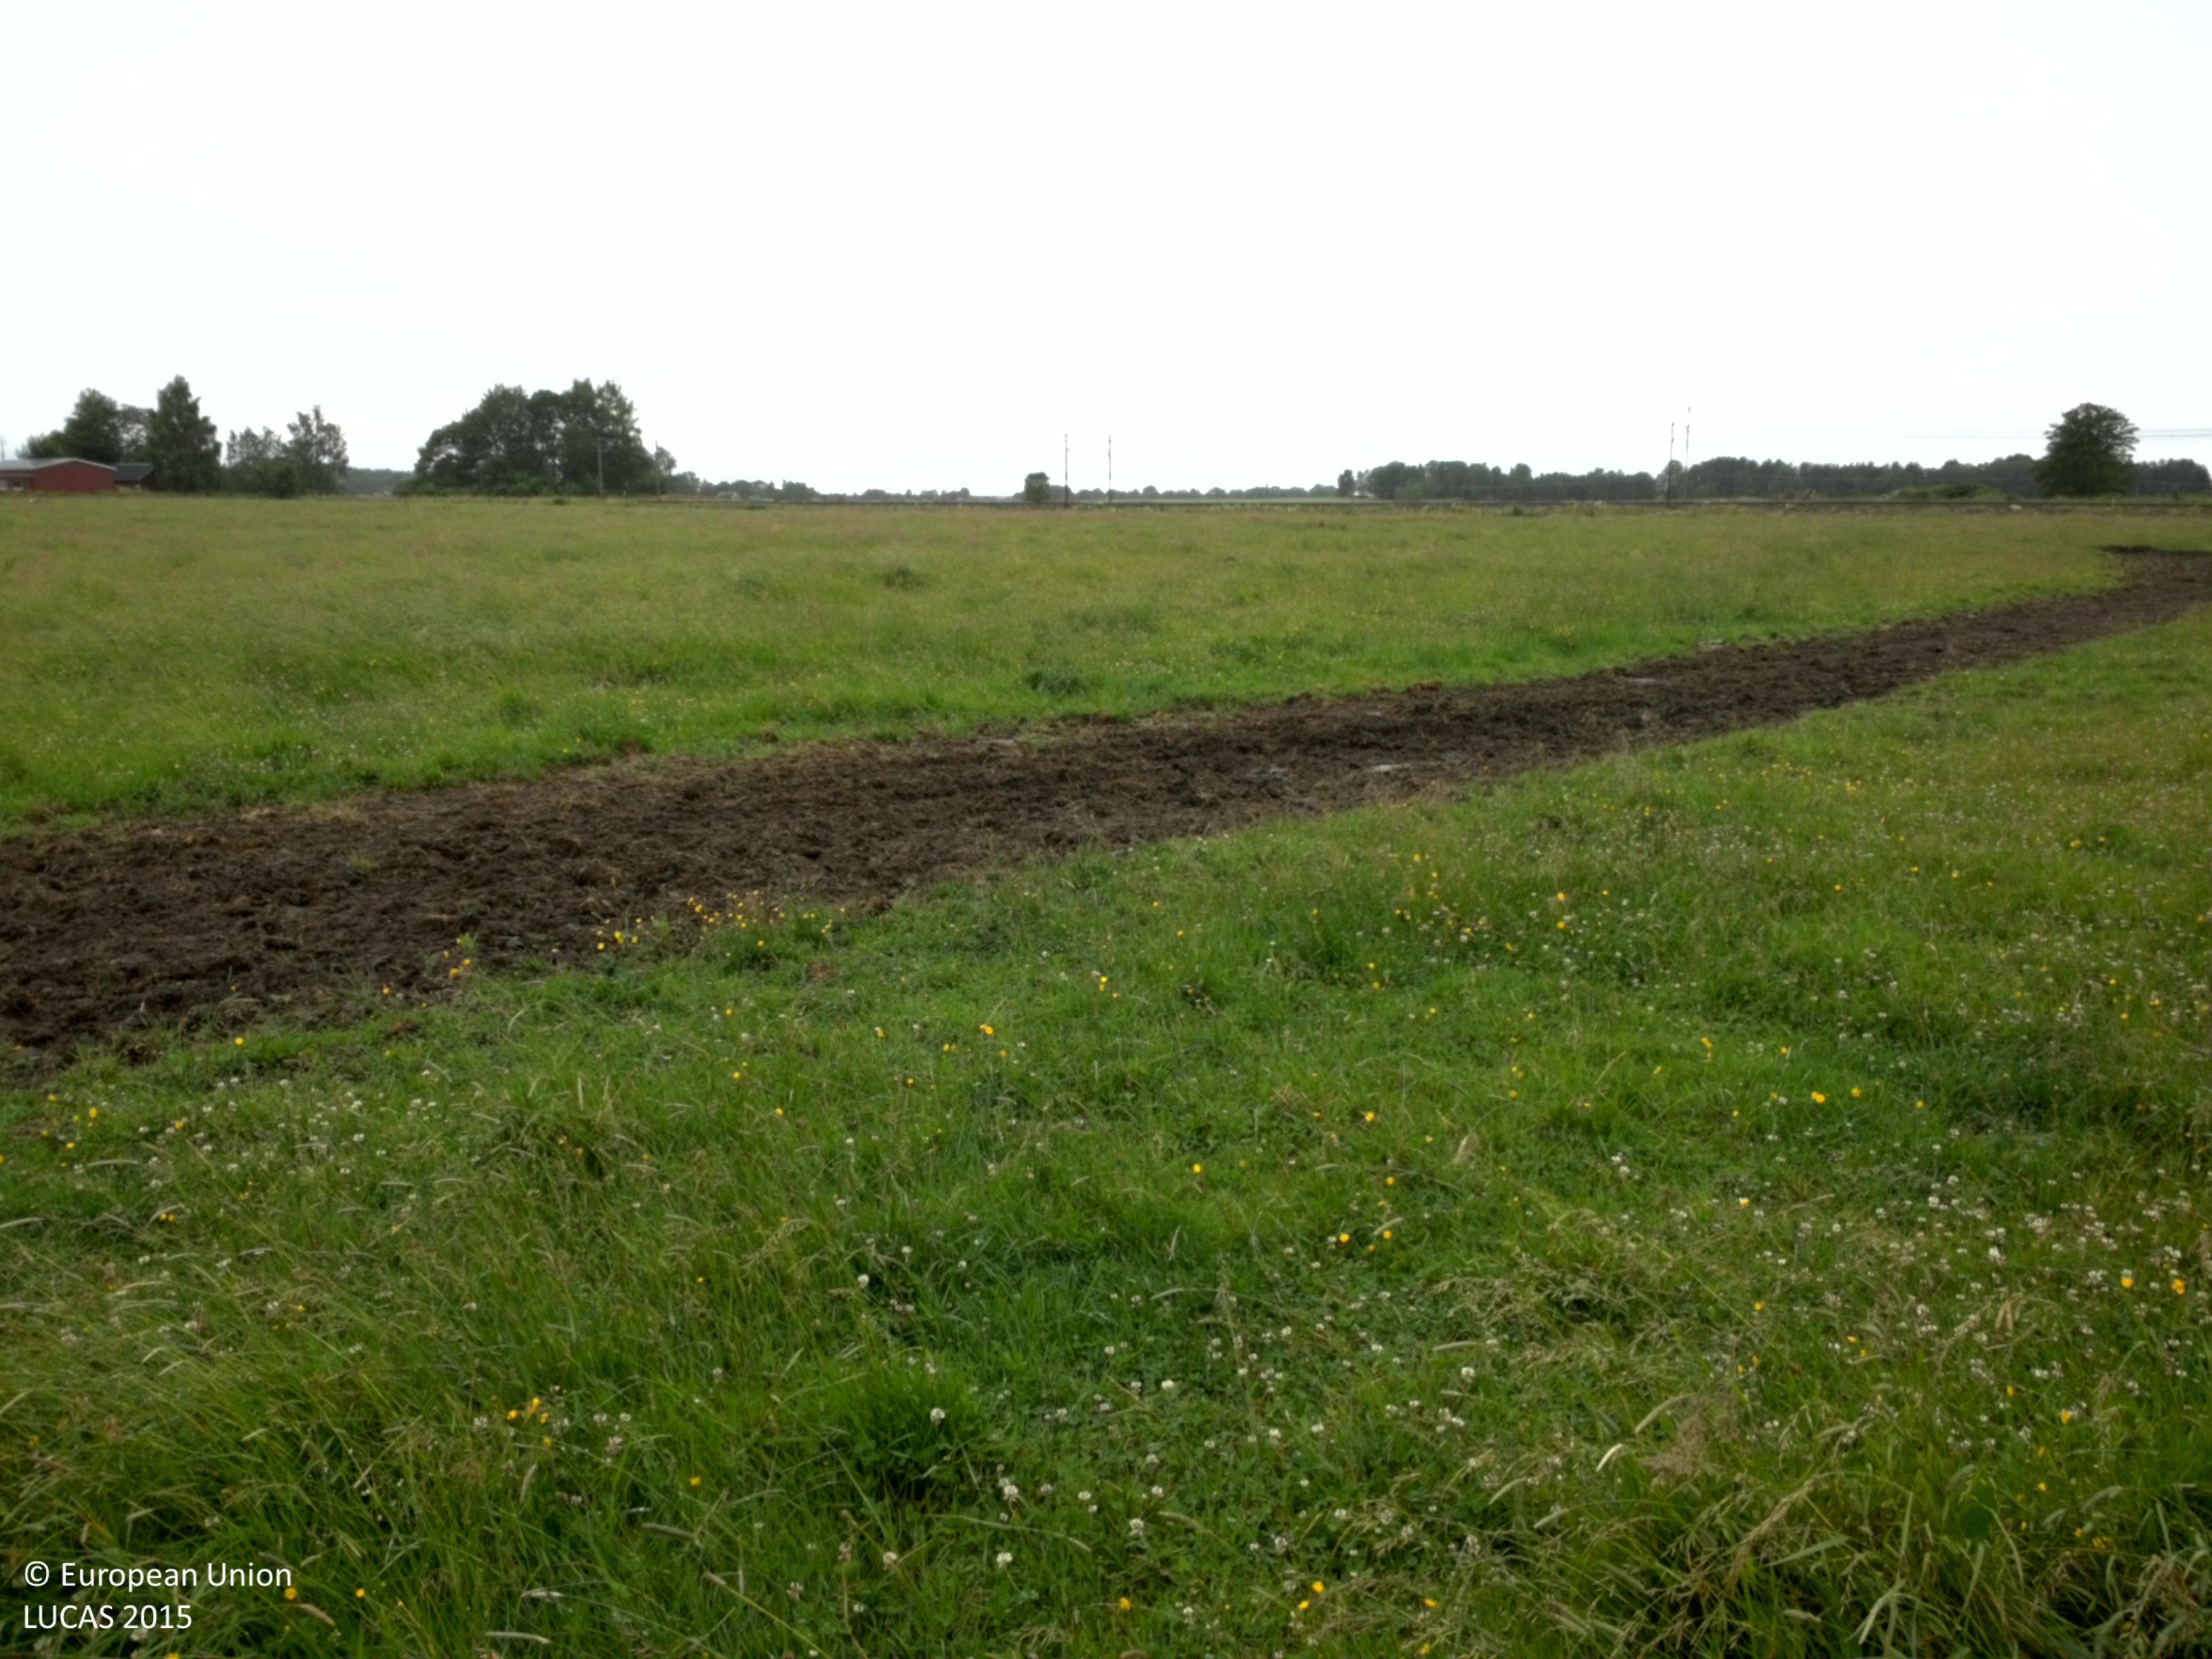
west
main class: Grassland
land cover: Grassland without tree/shrub cover
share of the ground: > 75 %
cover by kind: herbaceous plants 100 %
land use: Agriculture (excluding fallow land and kitchen gardens)
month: July
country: SE
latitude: 58.5564
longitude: 13.9980
